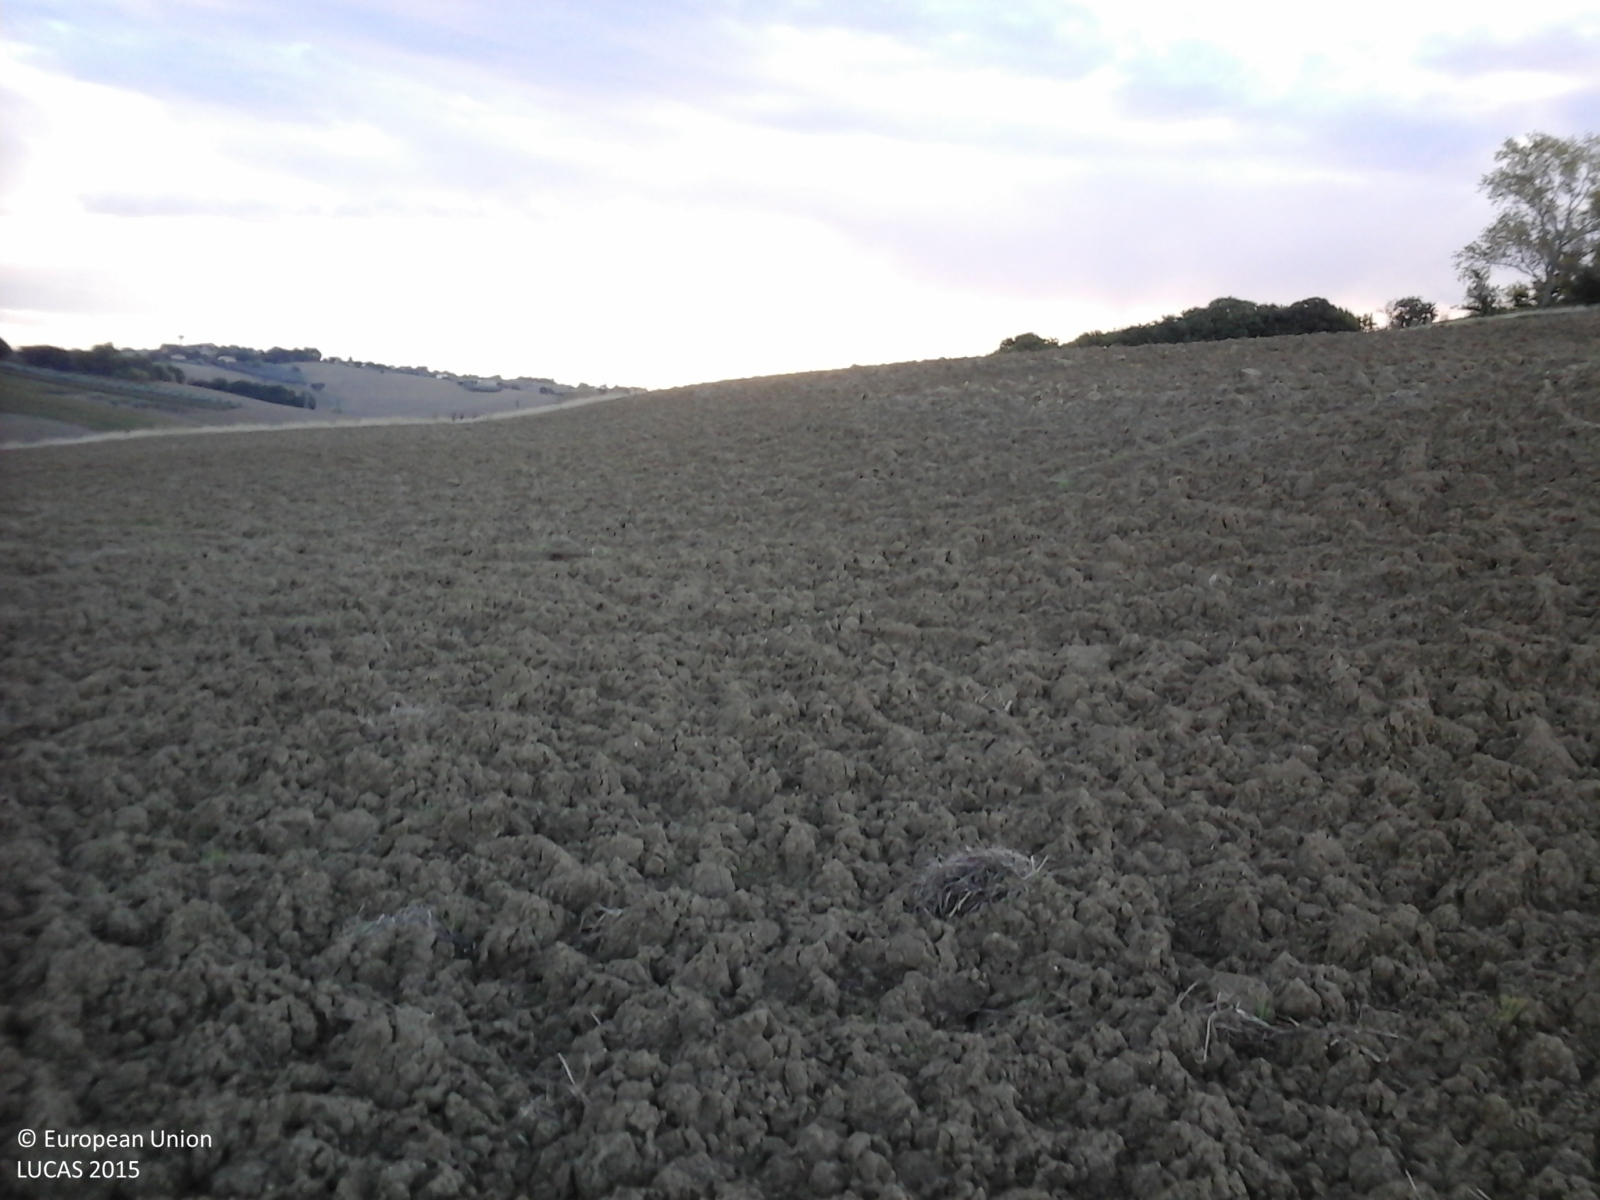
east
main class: Cropland
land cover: Durum wheat
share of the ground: < 10 %
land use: Agriculture (excluding fallow land and kitchen gardens)
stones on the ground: < 10 %
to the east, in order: Durum wheat; Spontaneously vegetated surfaces
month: October
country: IT
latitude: 43.5963
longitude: 13.2252
